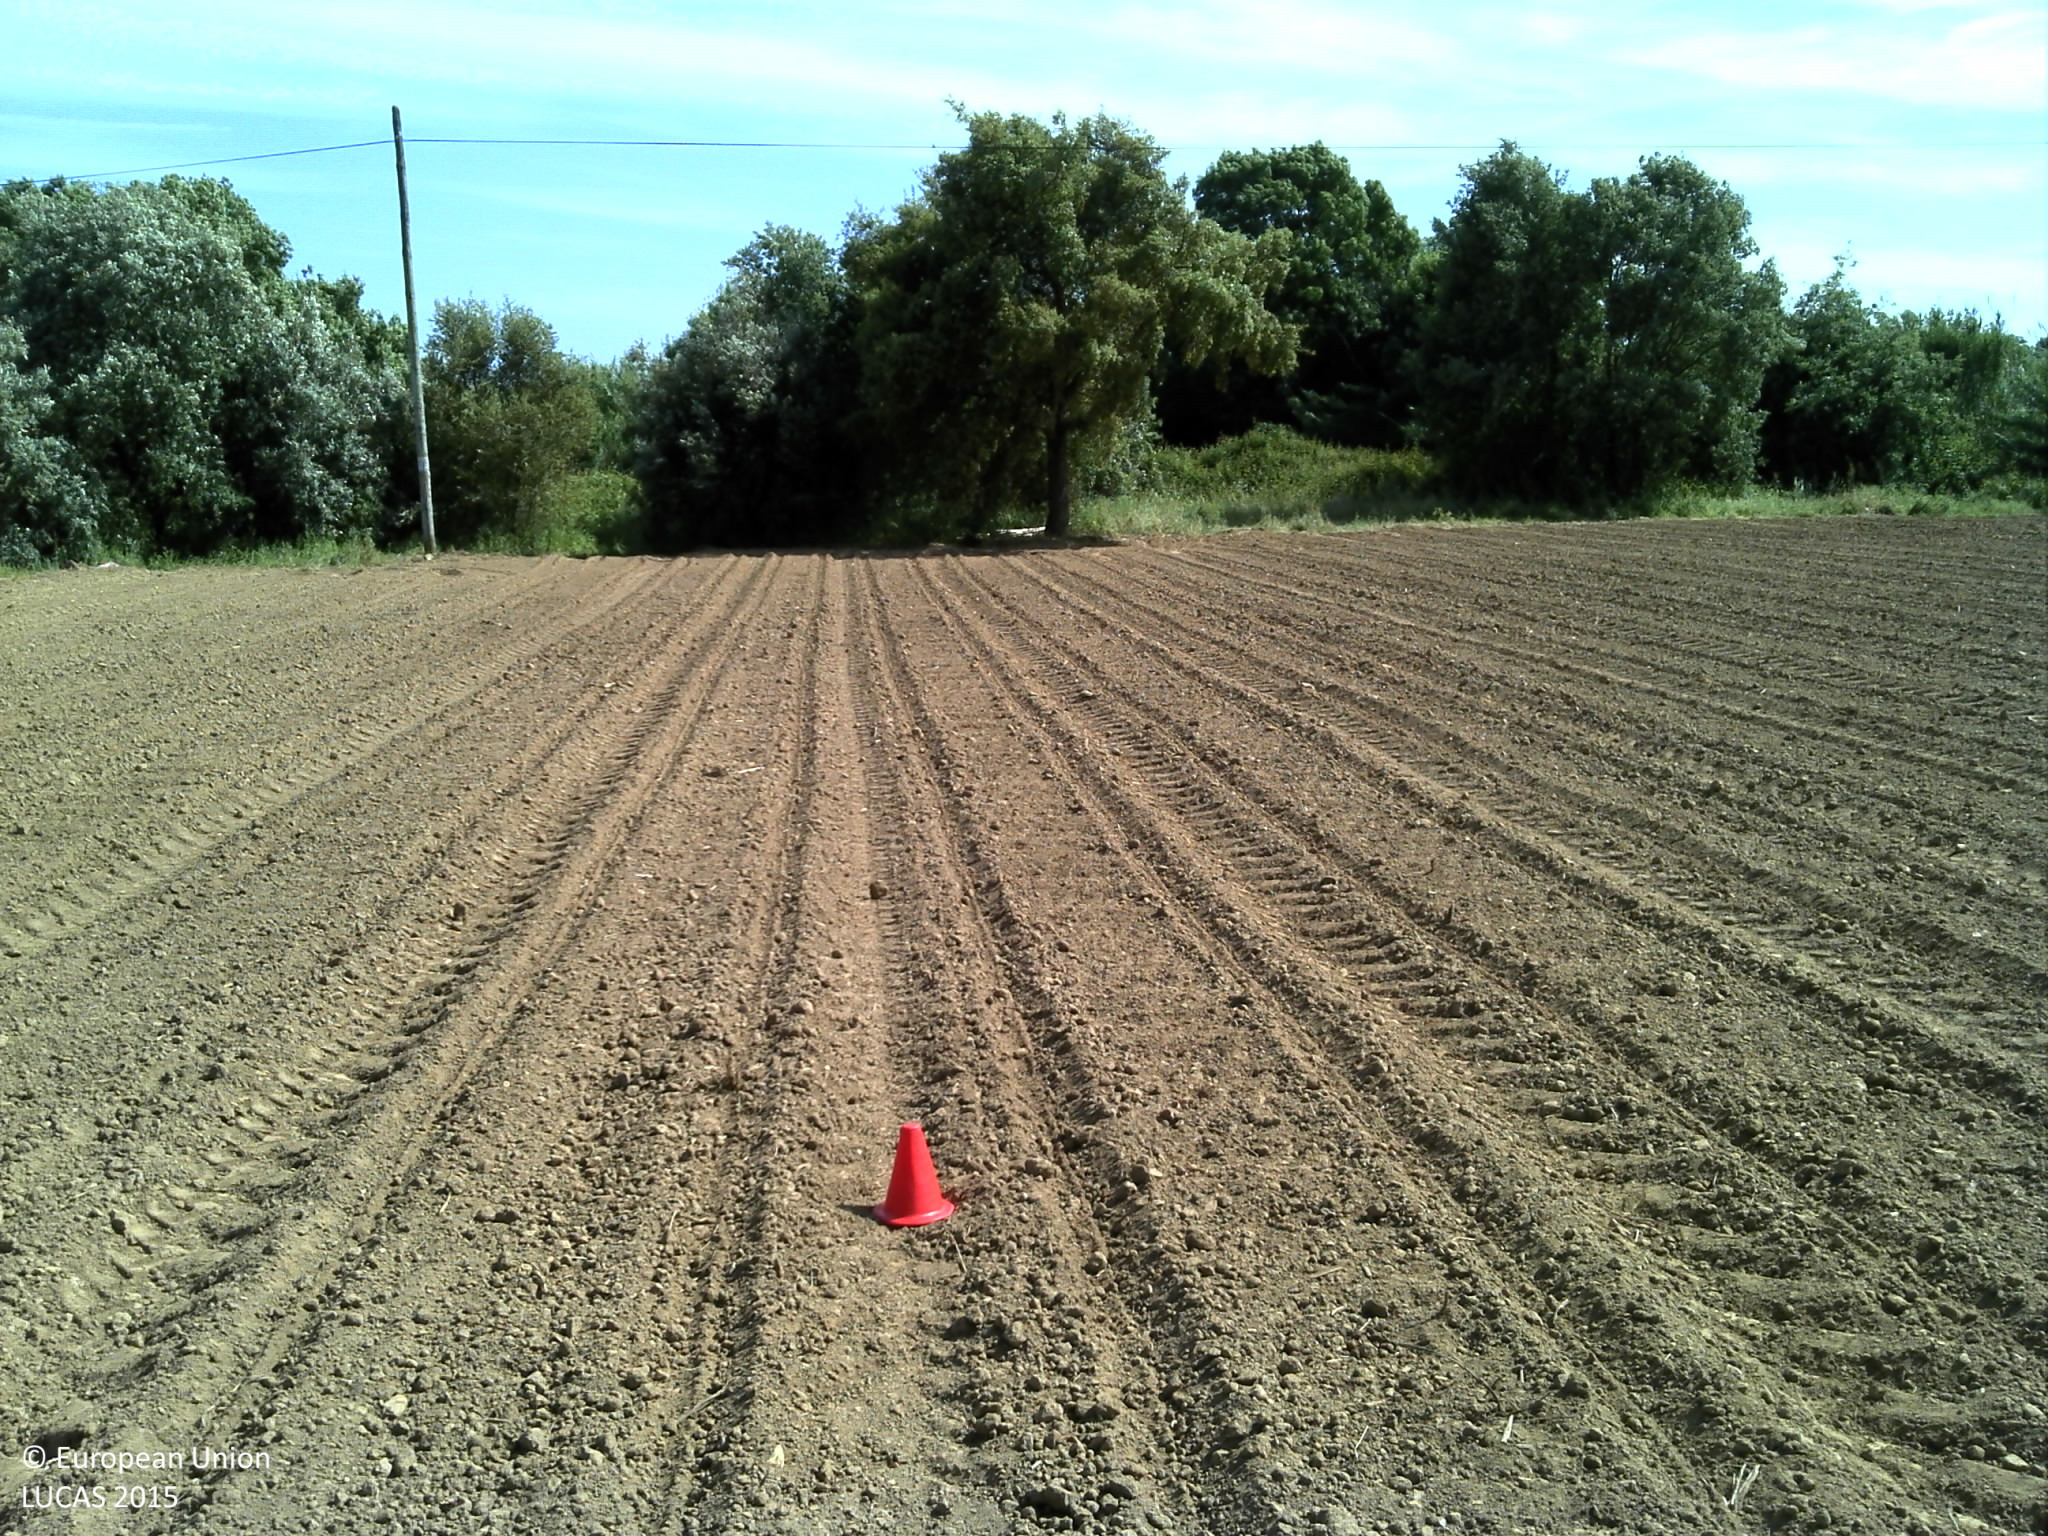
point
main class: Cropland
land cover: Maize
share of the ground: < 10 %
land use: Agriculture (excluding fallow land and kitchen gardens)
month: May
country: PT
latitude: 39.5900
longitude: -8.3632
